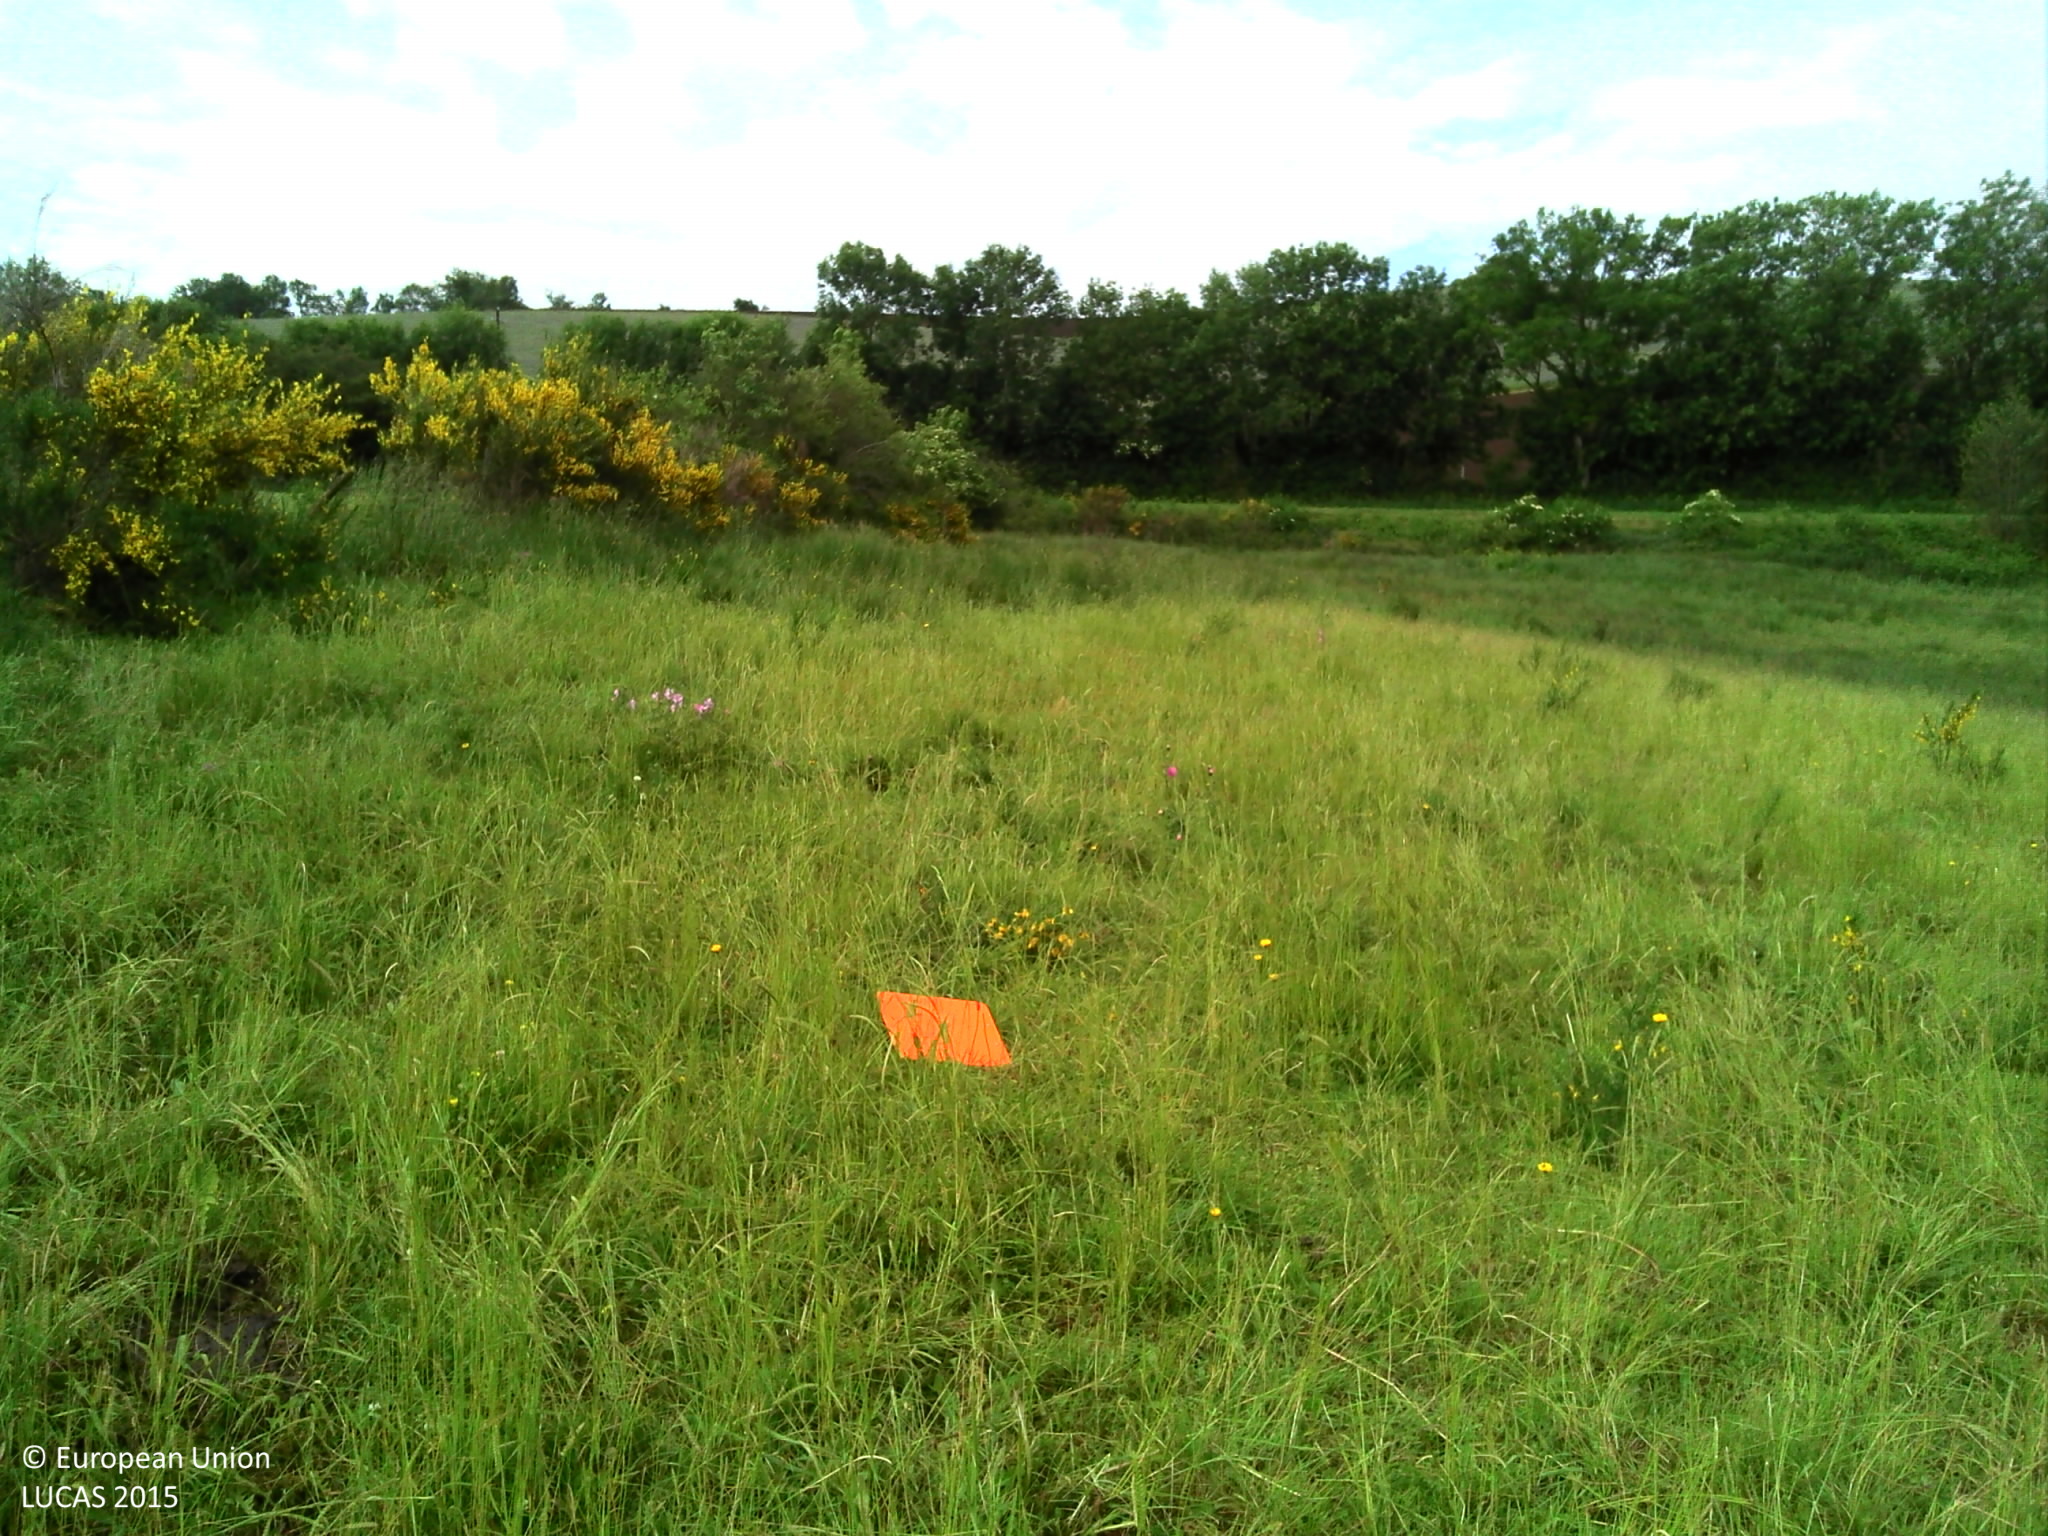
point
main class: Grassland
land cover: Grassland without tree/shrub cover
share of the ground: > 75 %
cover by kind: herbaceous plants 95 %, shrubs 5 %
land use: Agriculture (excluding fallow land and kitchen gardens)
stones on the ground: 10 - 25 %
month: June
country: FR
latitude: 44.2574
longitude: 2.9784
